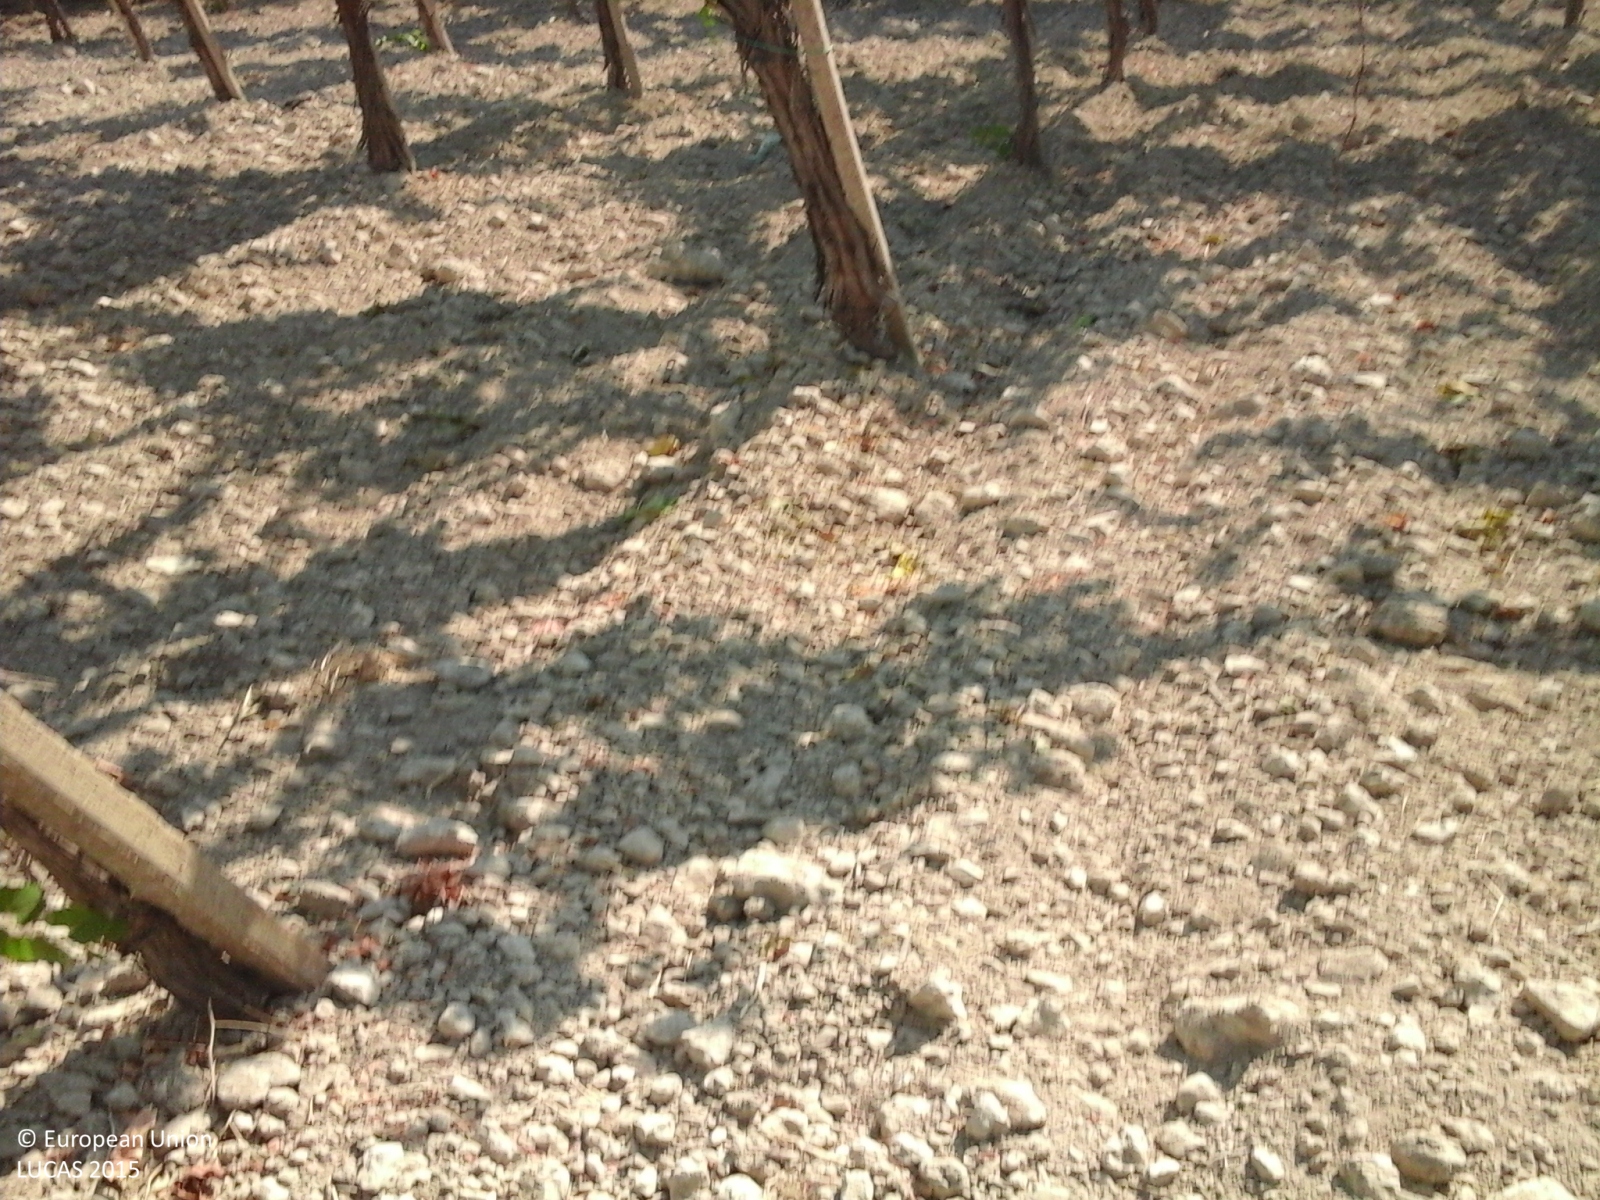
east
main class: Cropland
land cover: Vineyards
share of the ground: > 75 %
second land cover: Other bare soil
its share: > 75 %
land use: Agriculture (excluding fallow land and kitchen gardens)
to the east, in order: Vineyards; Other bare soil; Vineyards
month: July
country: IT
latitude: 37.2408
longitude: 14.1052
